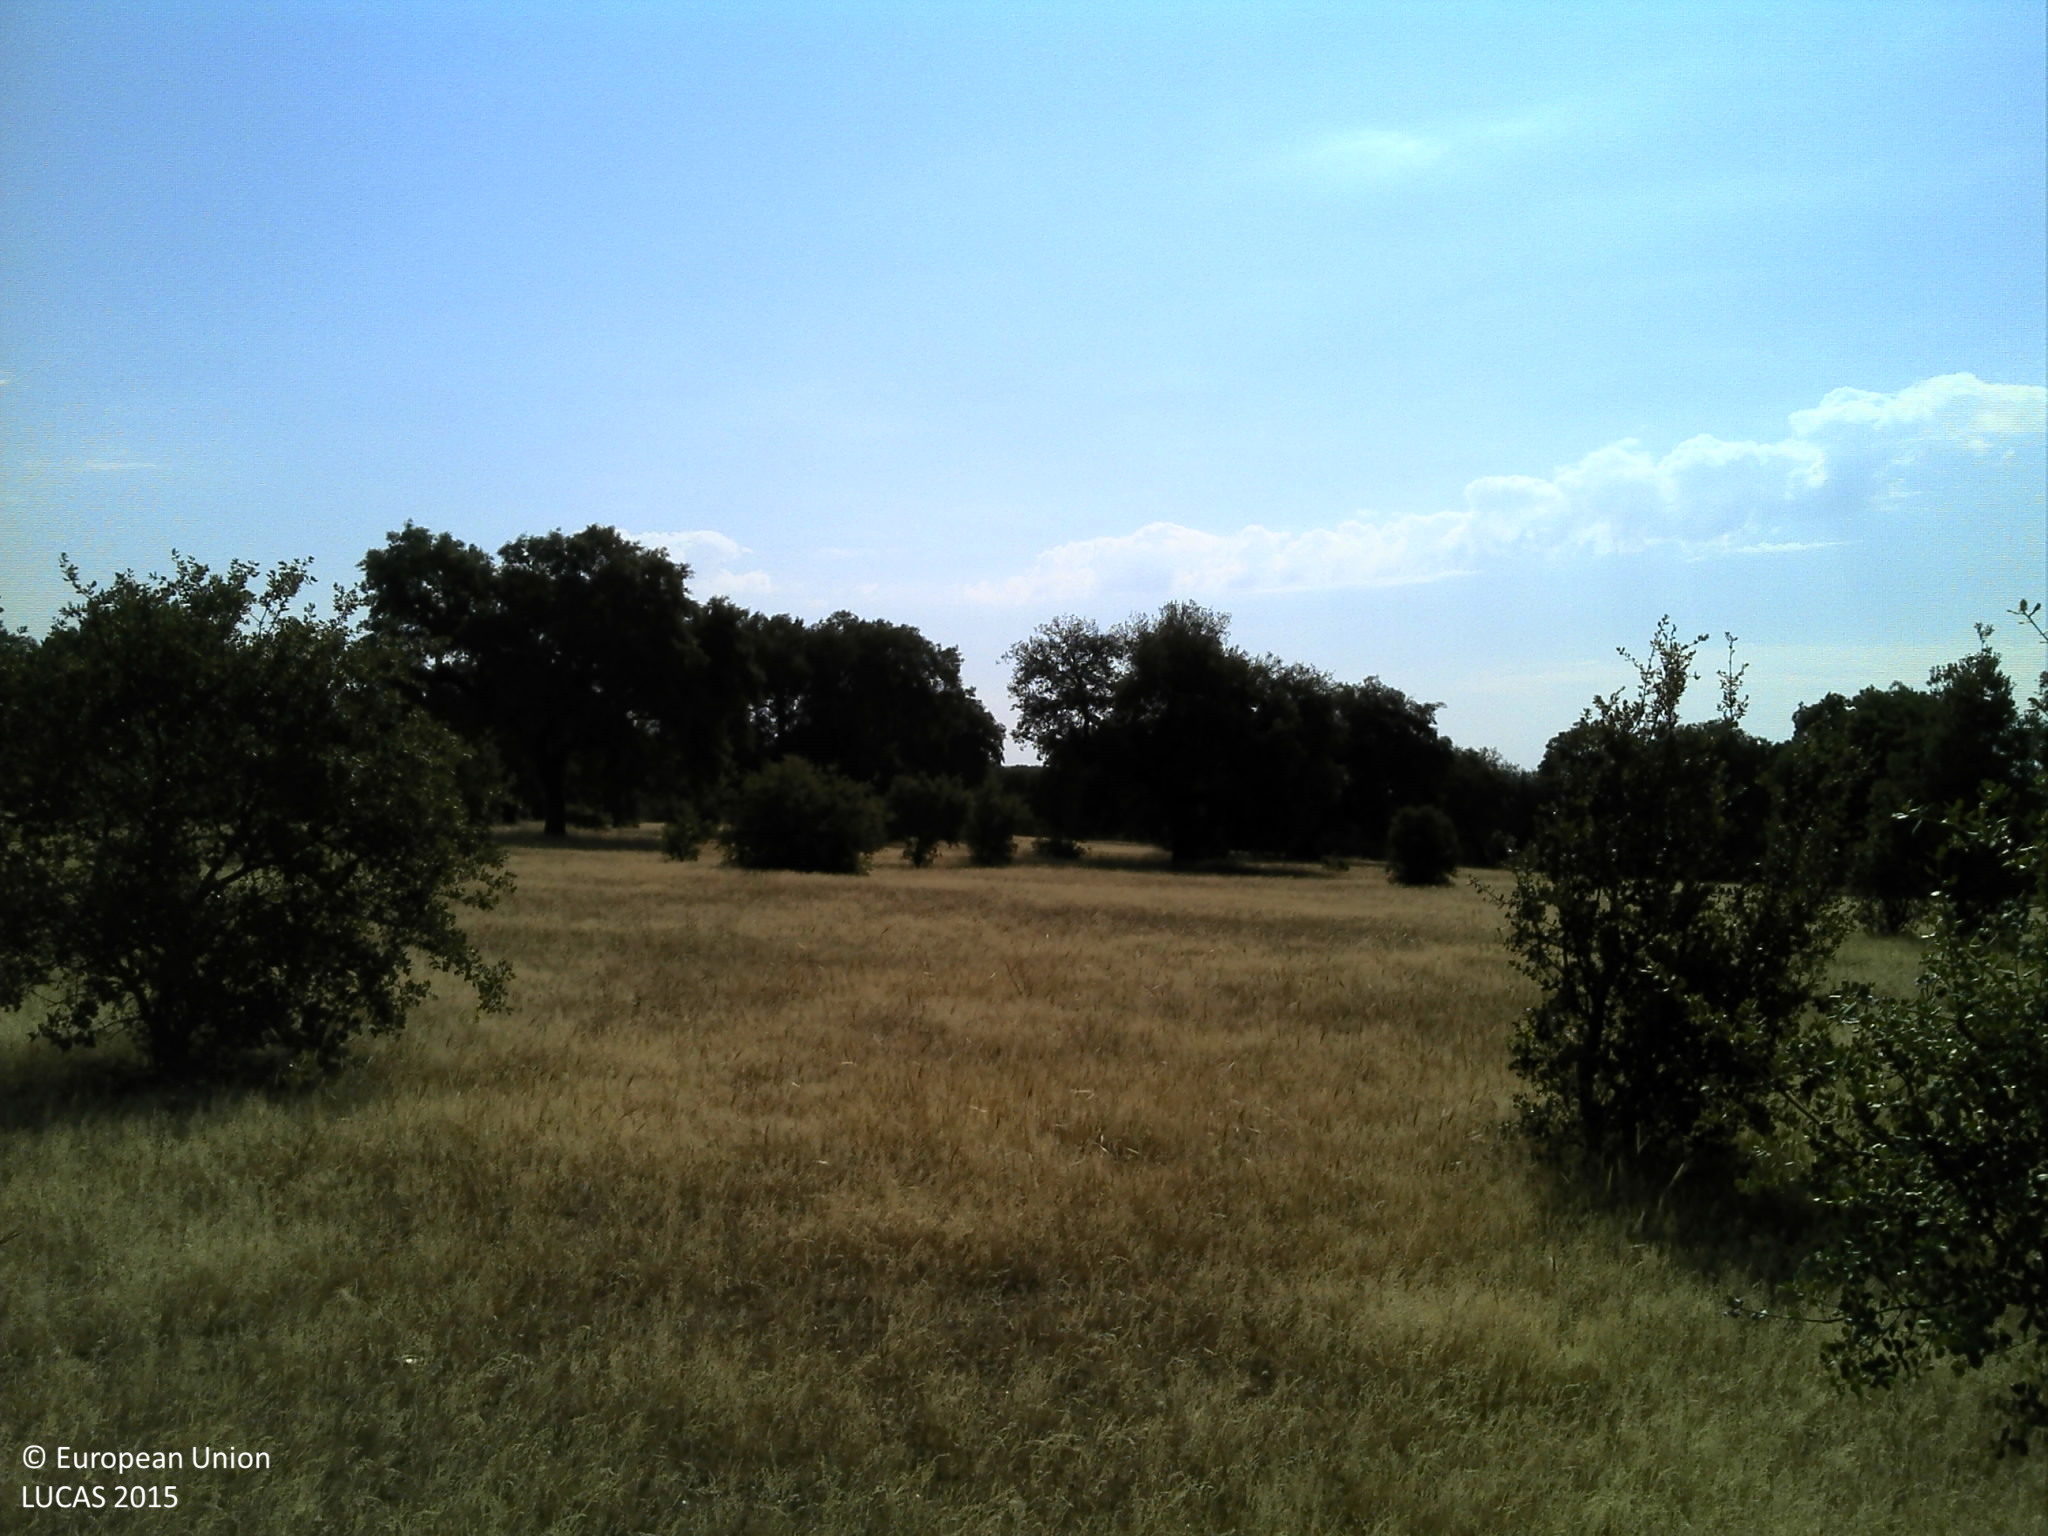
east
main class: Woodland
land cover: Broadleaved woodland
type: broadleaved evergreen forest
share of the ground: 10 - 25 %
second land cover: Grassland without tree/shrub cover
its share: 50 - 75 %
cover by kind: herbaceous plants 75 %, broadleaved forest trees 15 %, unconsolidated bare surface 10 %
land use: Forestry
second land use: Agriculture (excluding fallow land and kitchen gardens)
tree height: > 5 m
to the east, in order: Broadleaved woodland; Grassland without tree/shrub cover; Fences; Grass margins; Paved roads, cycling and walking lanes; Grass margins; Fences; Broadleaved woodland
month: May
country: PT
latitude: 38.8779
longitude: -7.8294
